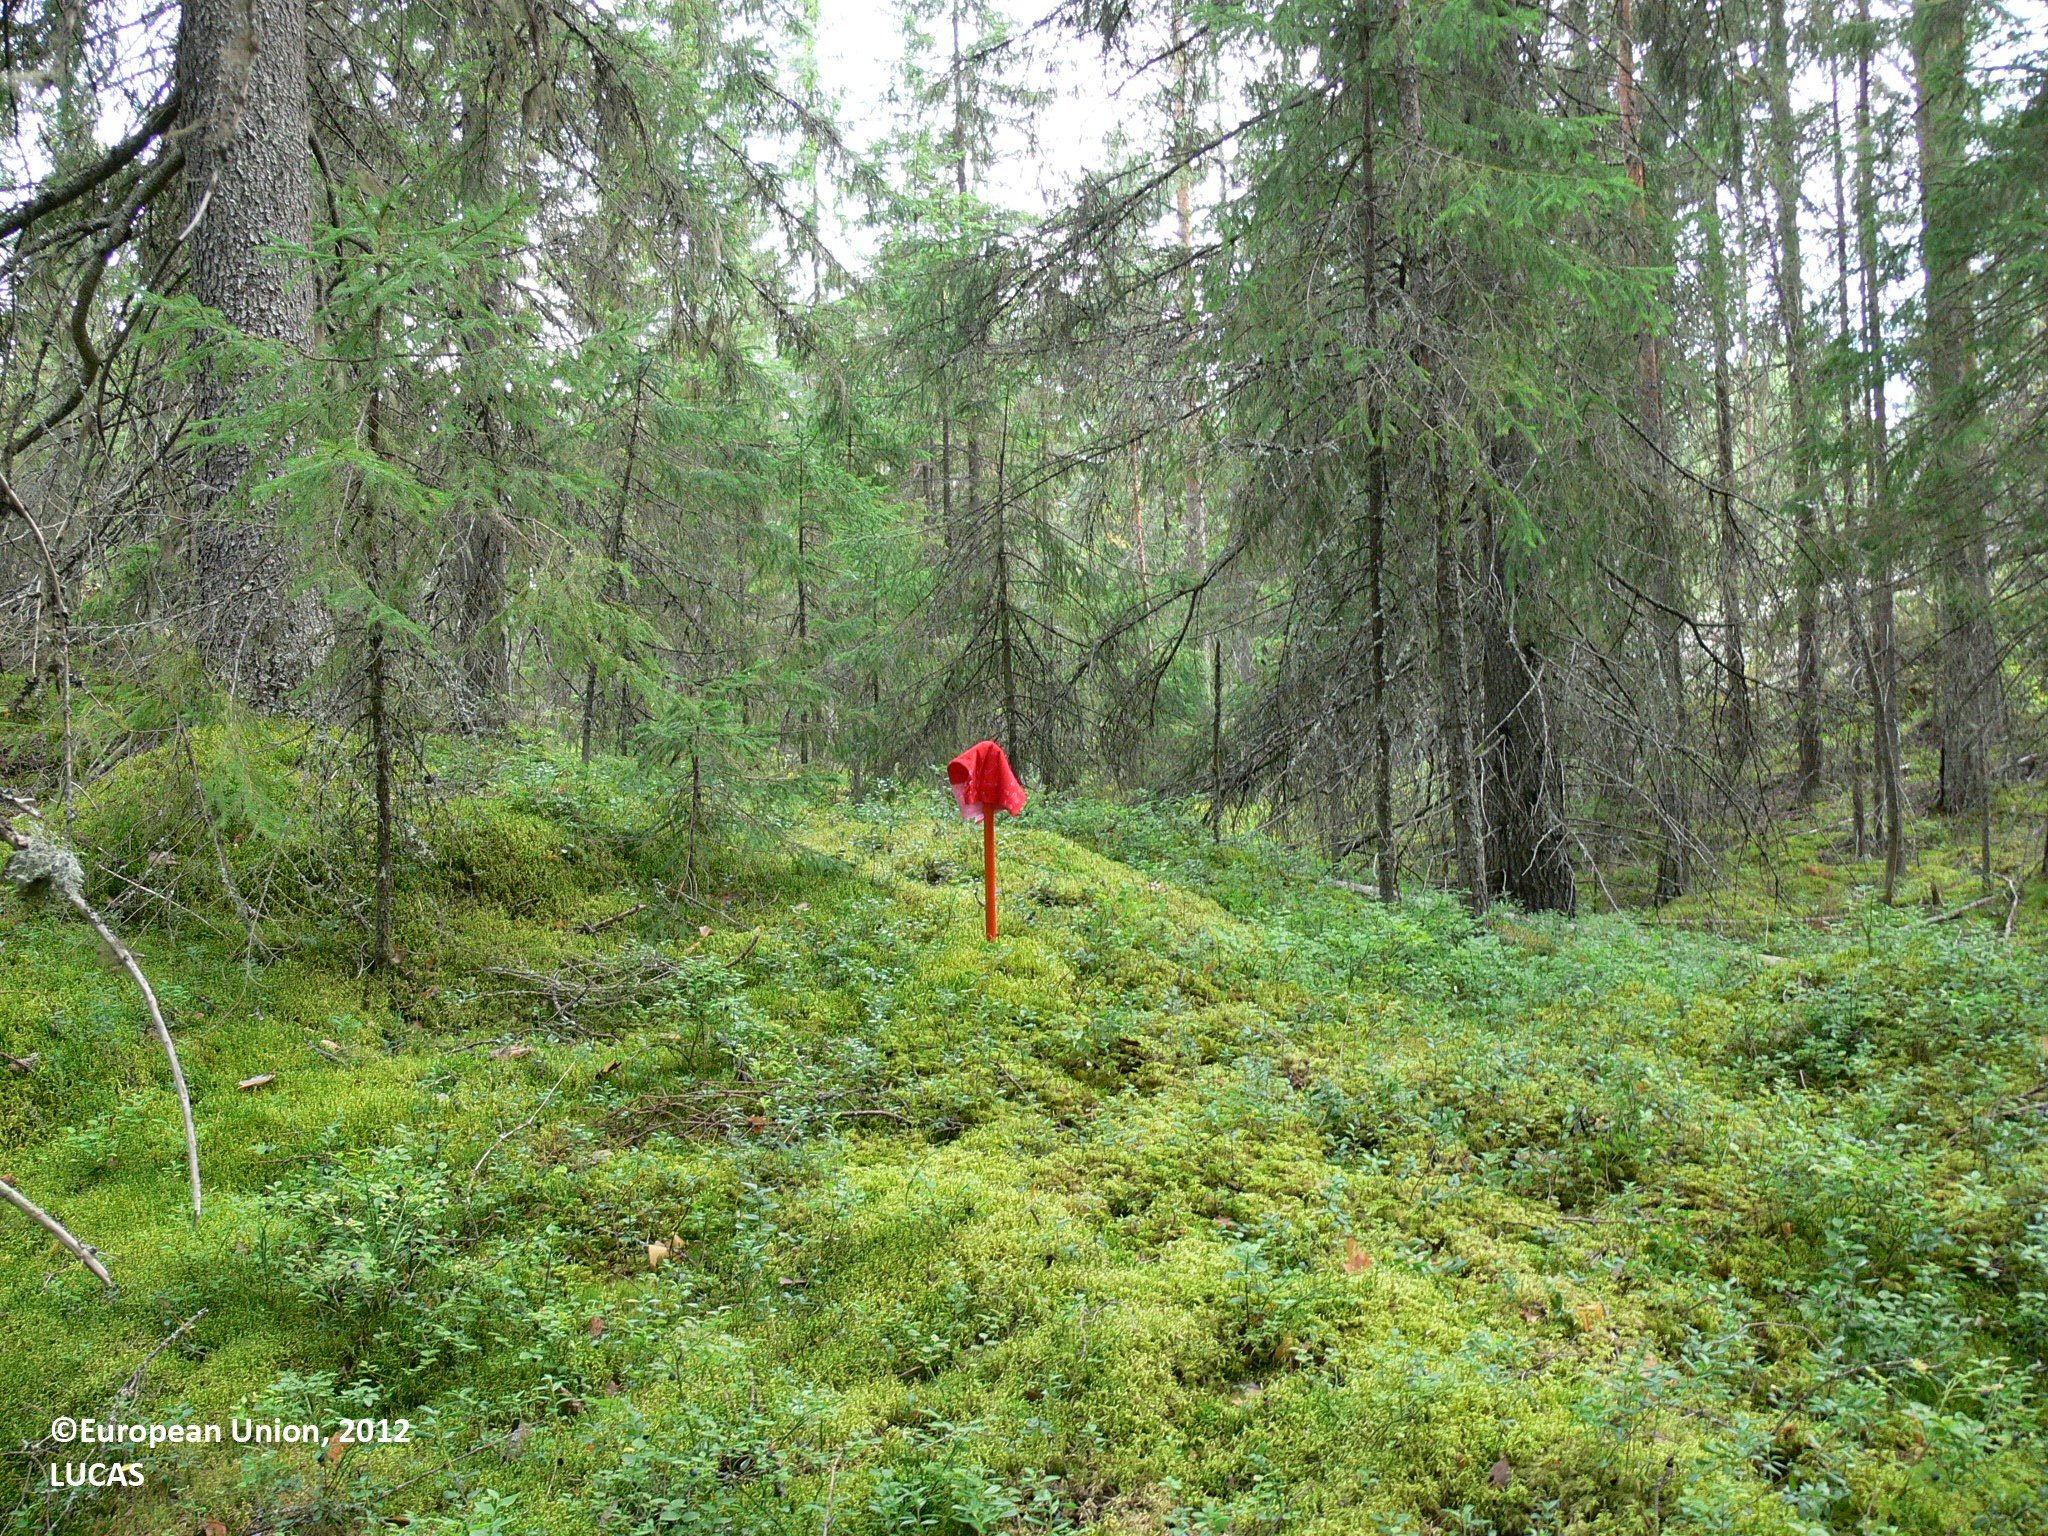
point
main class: Woodland
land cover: Other coniferous woodland
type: boreal forest
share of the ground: > 75 %
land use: Forestry
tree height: > 5 m
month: August
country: FI
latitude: 61.7320
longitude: 29.1821
